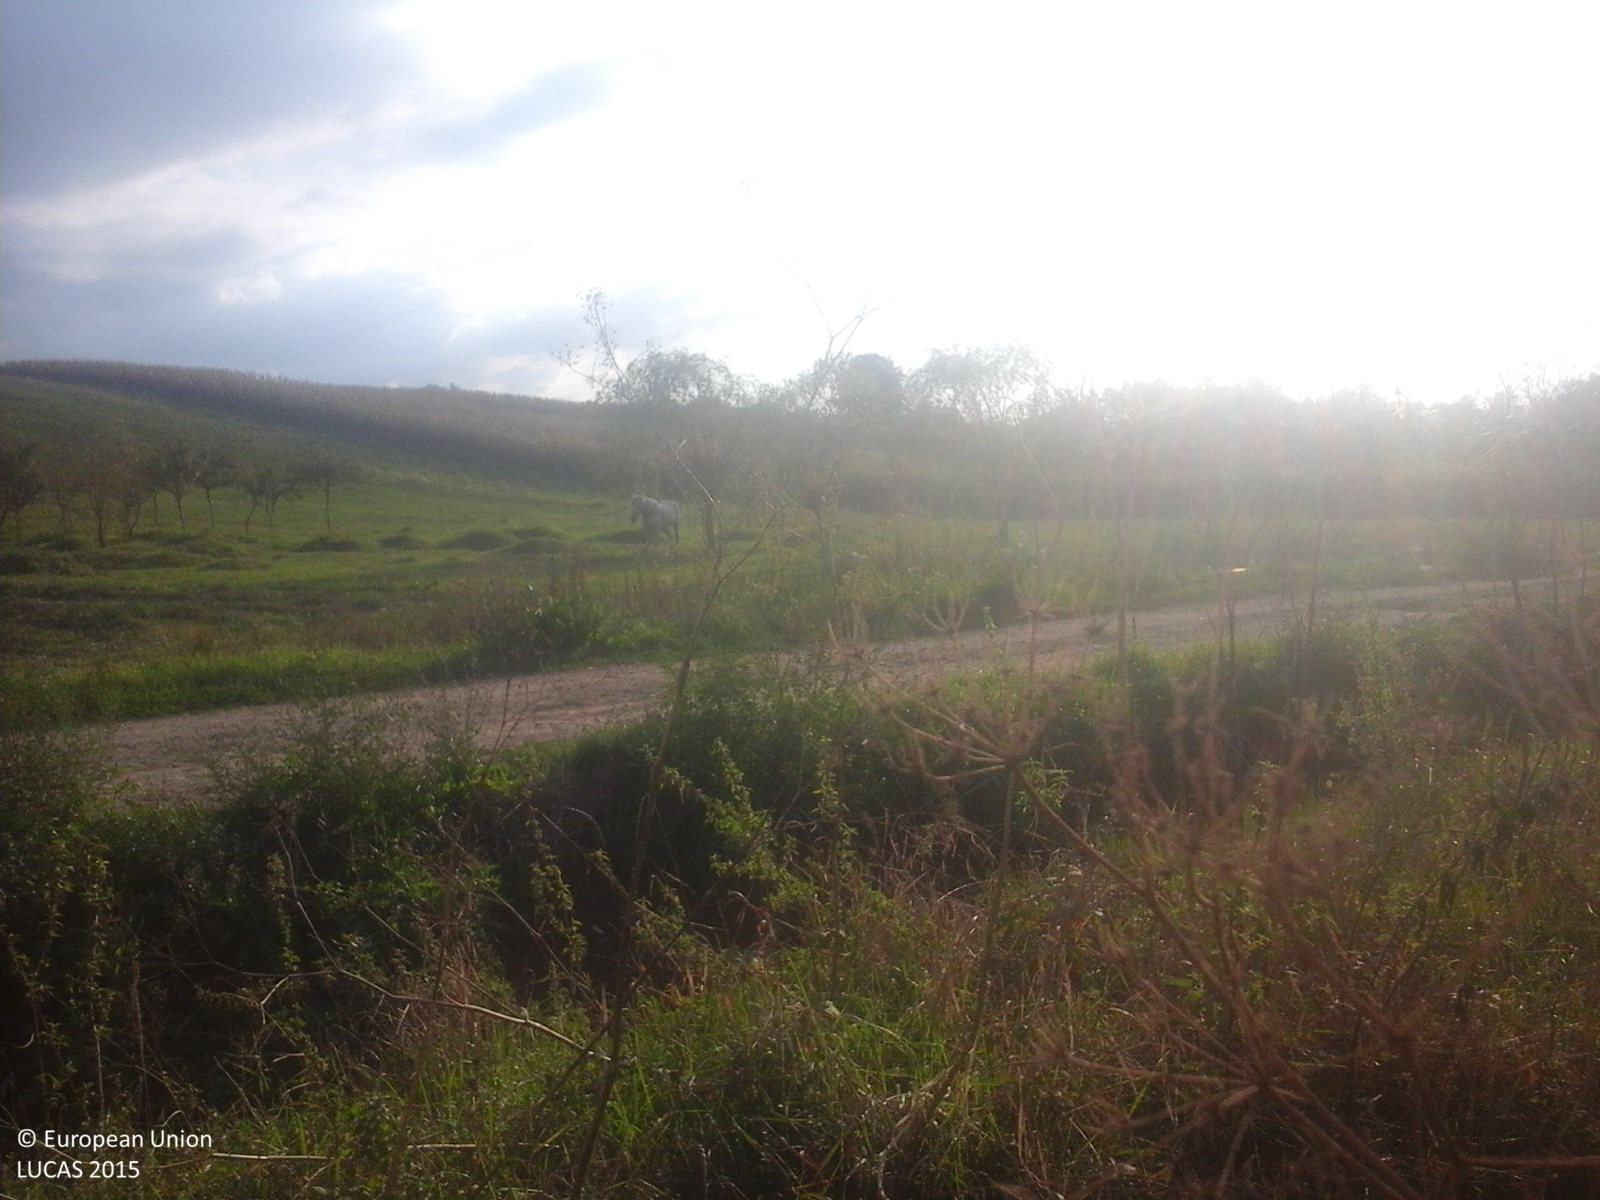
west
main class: Cropland
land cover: Sunflower
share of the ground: > 75 %
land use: Agriculture (excluding fallow land and kitchen gardens)
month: September
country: RO
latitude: 47.3213
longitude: 22.8556
